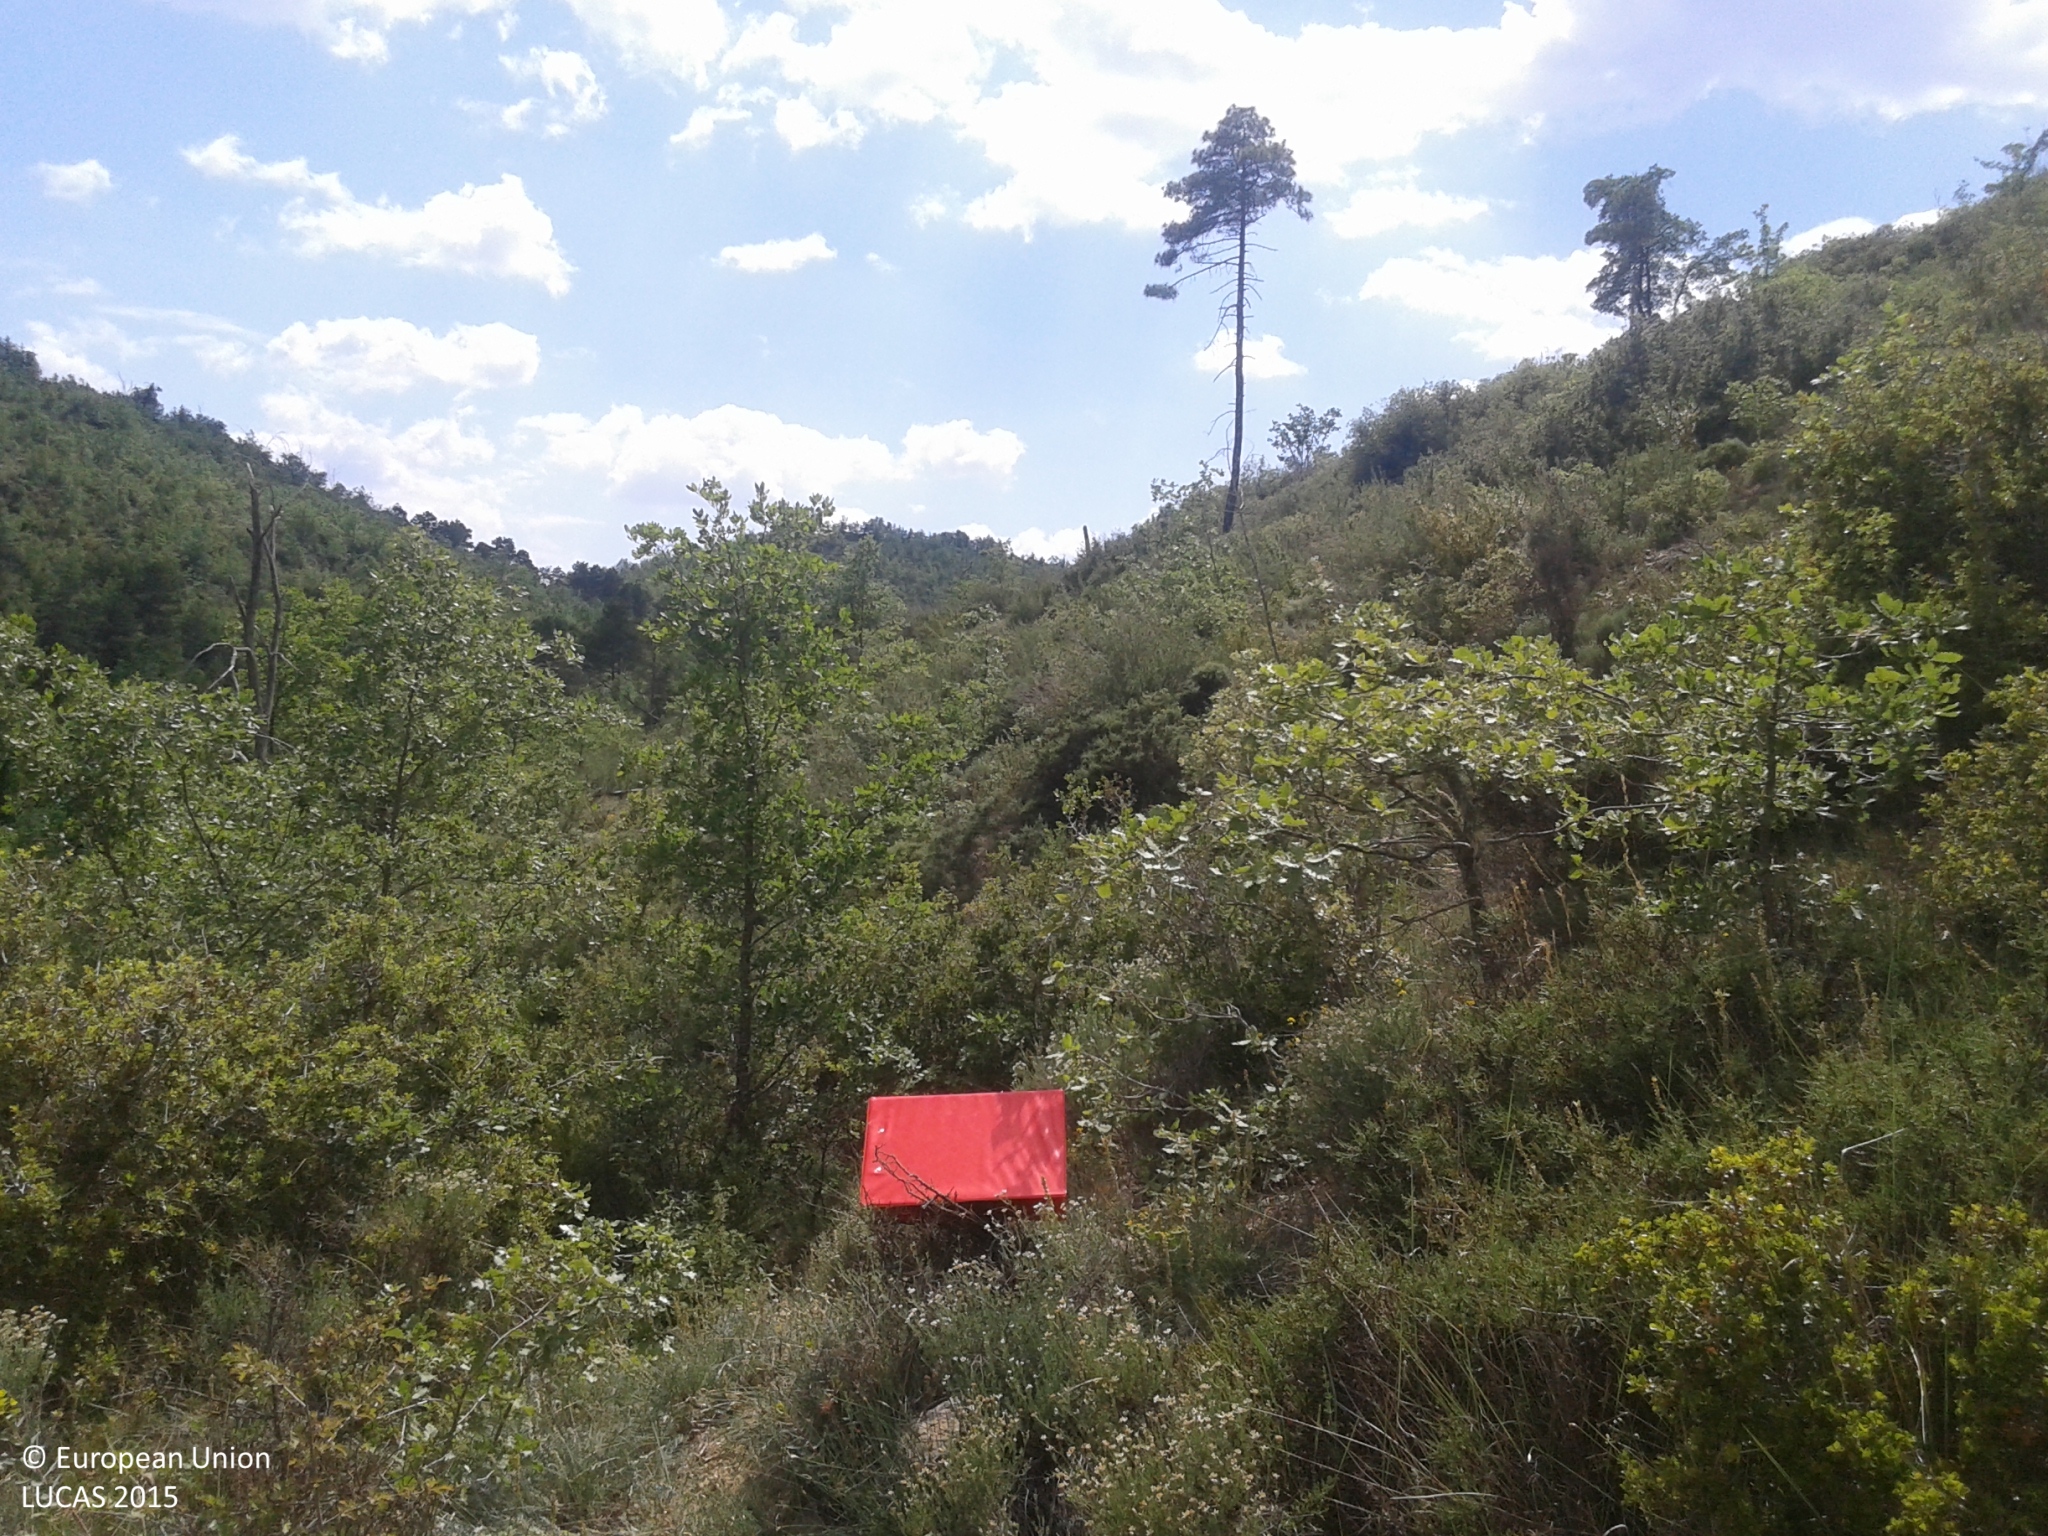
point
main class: Woodland
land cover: Broadleaved woodland
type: thermophilous deciduous forest
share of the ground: 10 - 25 %
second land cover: Shrubland without tree cover
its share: 25 - 50 %
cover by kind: shrubs 75 %, broadleaved forest trees 15 %, herbaceous plants 10 %
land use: Forestry
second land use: Agriculture (excluding fallow land and kitchen gardens)
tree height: < 5 m
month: May
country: ES
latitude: 41.9042
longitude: 1.5871
